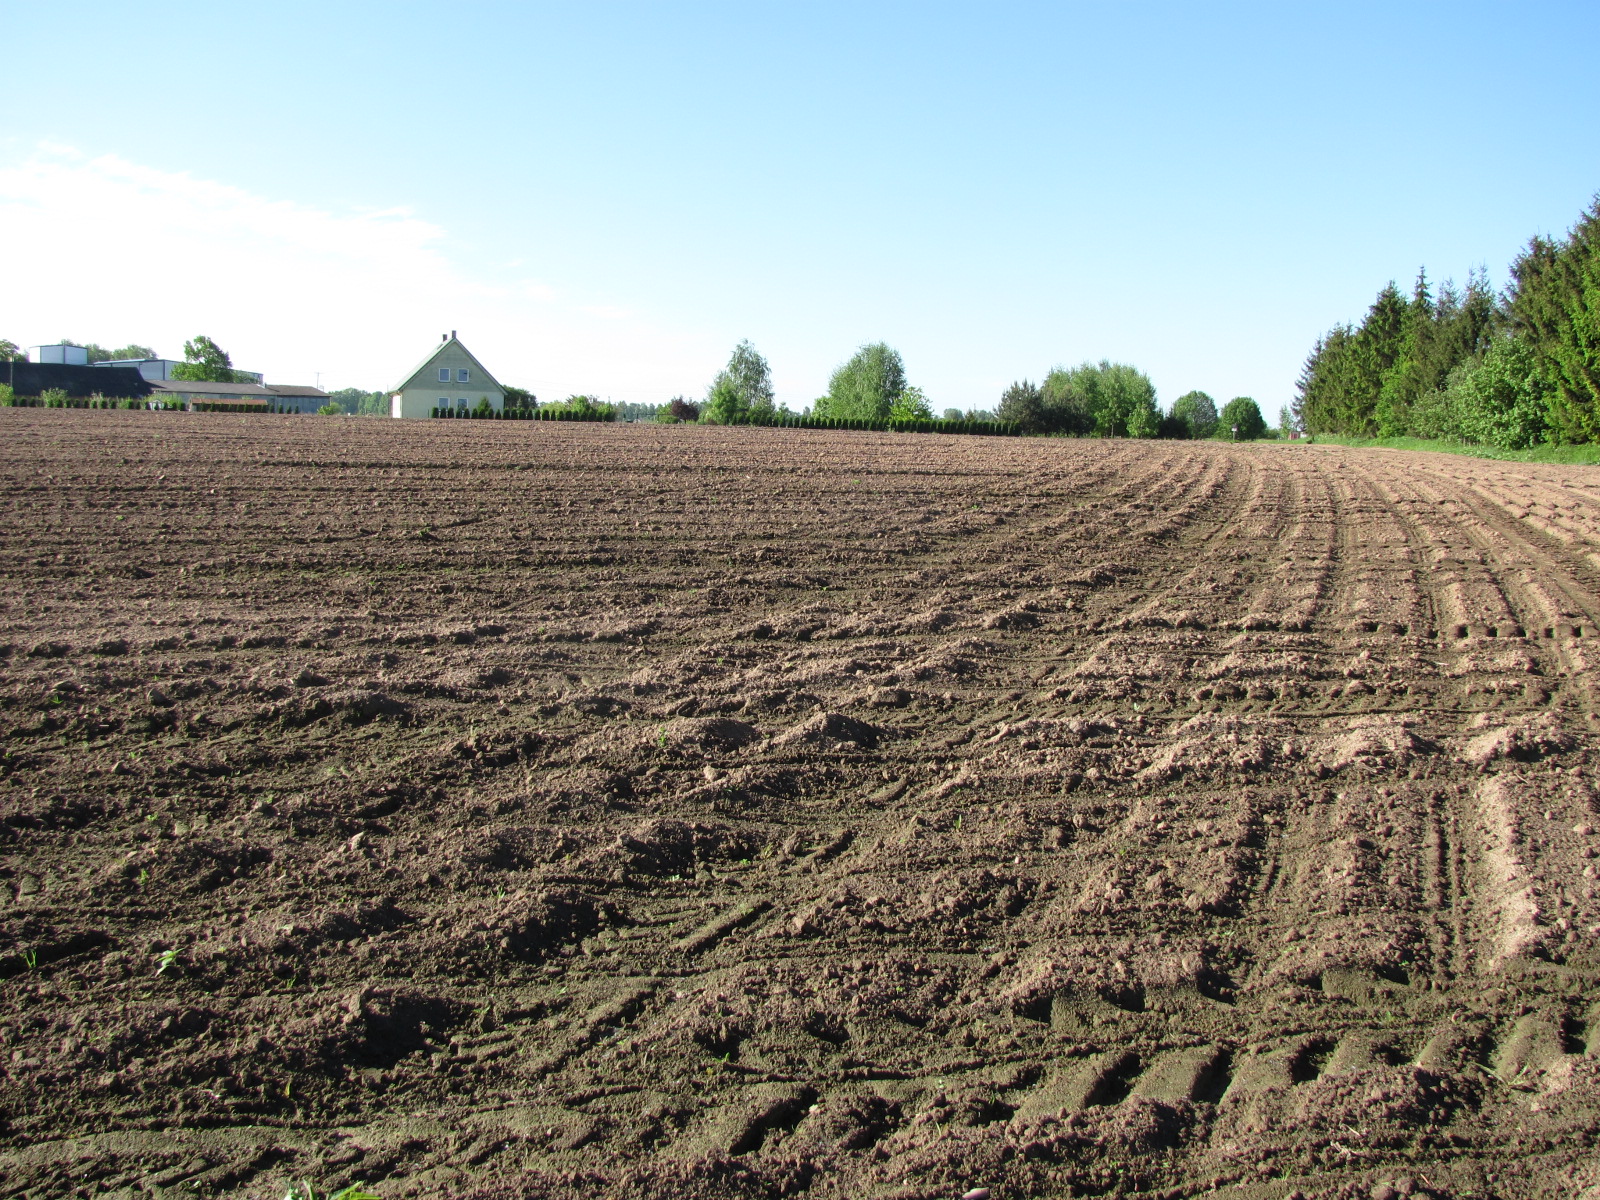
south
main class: Cropland
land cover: Maize
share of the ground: < 10 %
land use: Agriculture (excluding fallow land and kitchen gardens)
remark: Tilled/Sowed
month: May
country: LV
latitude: 56.6162
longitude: 24.2172
